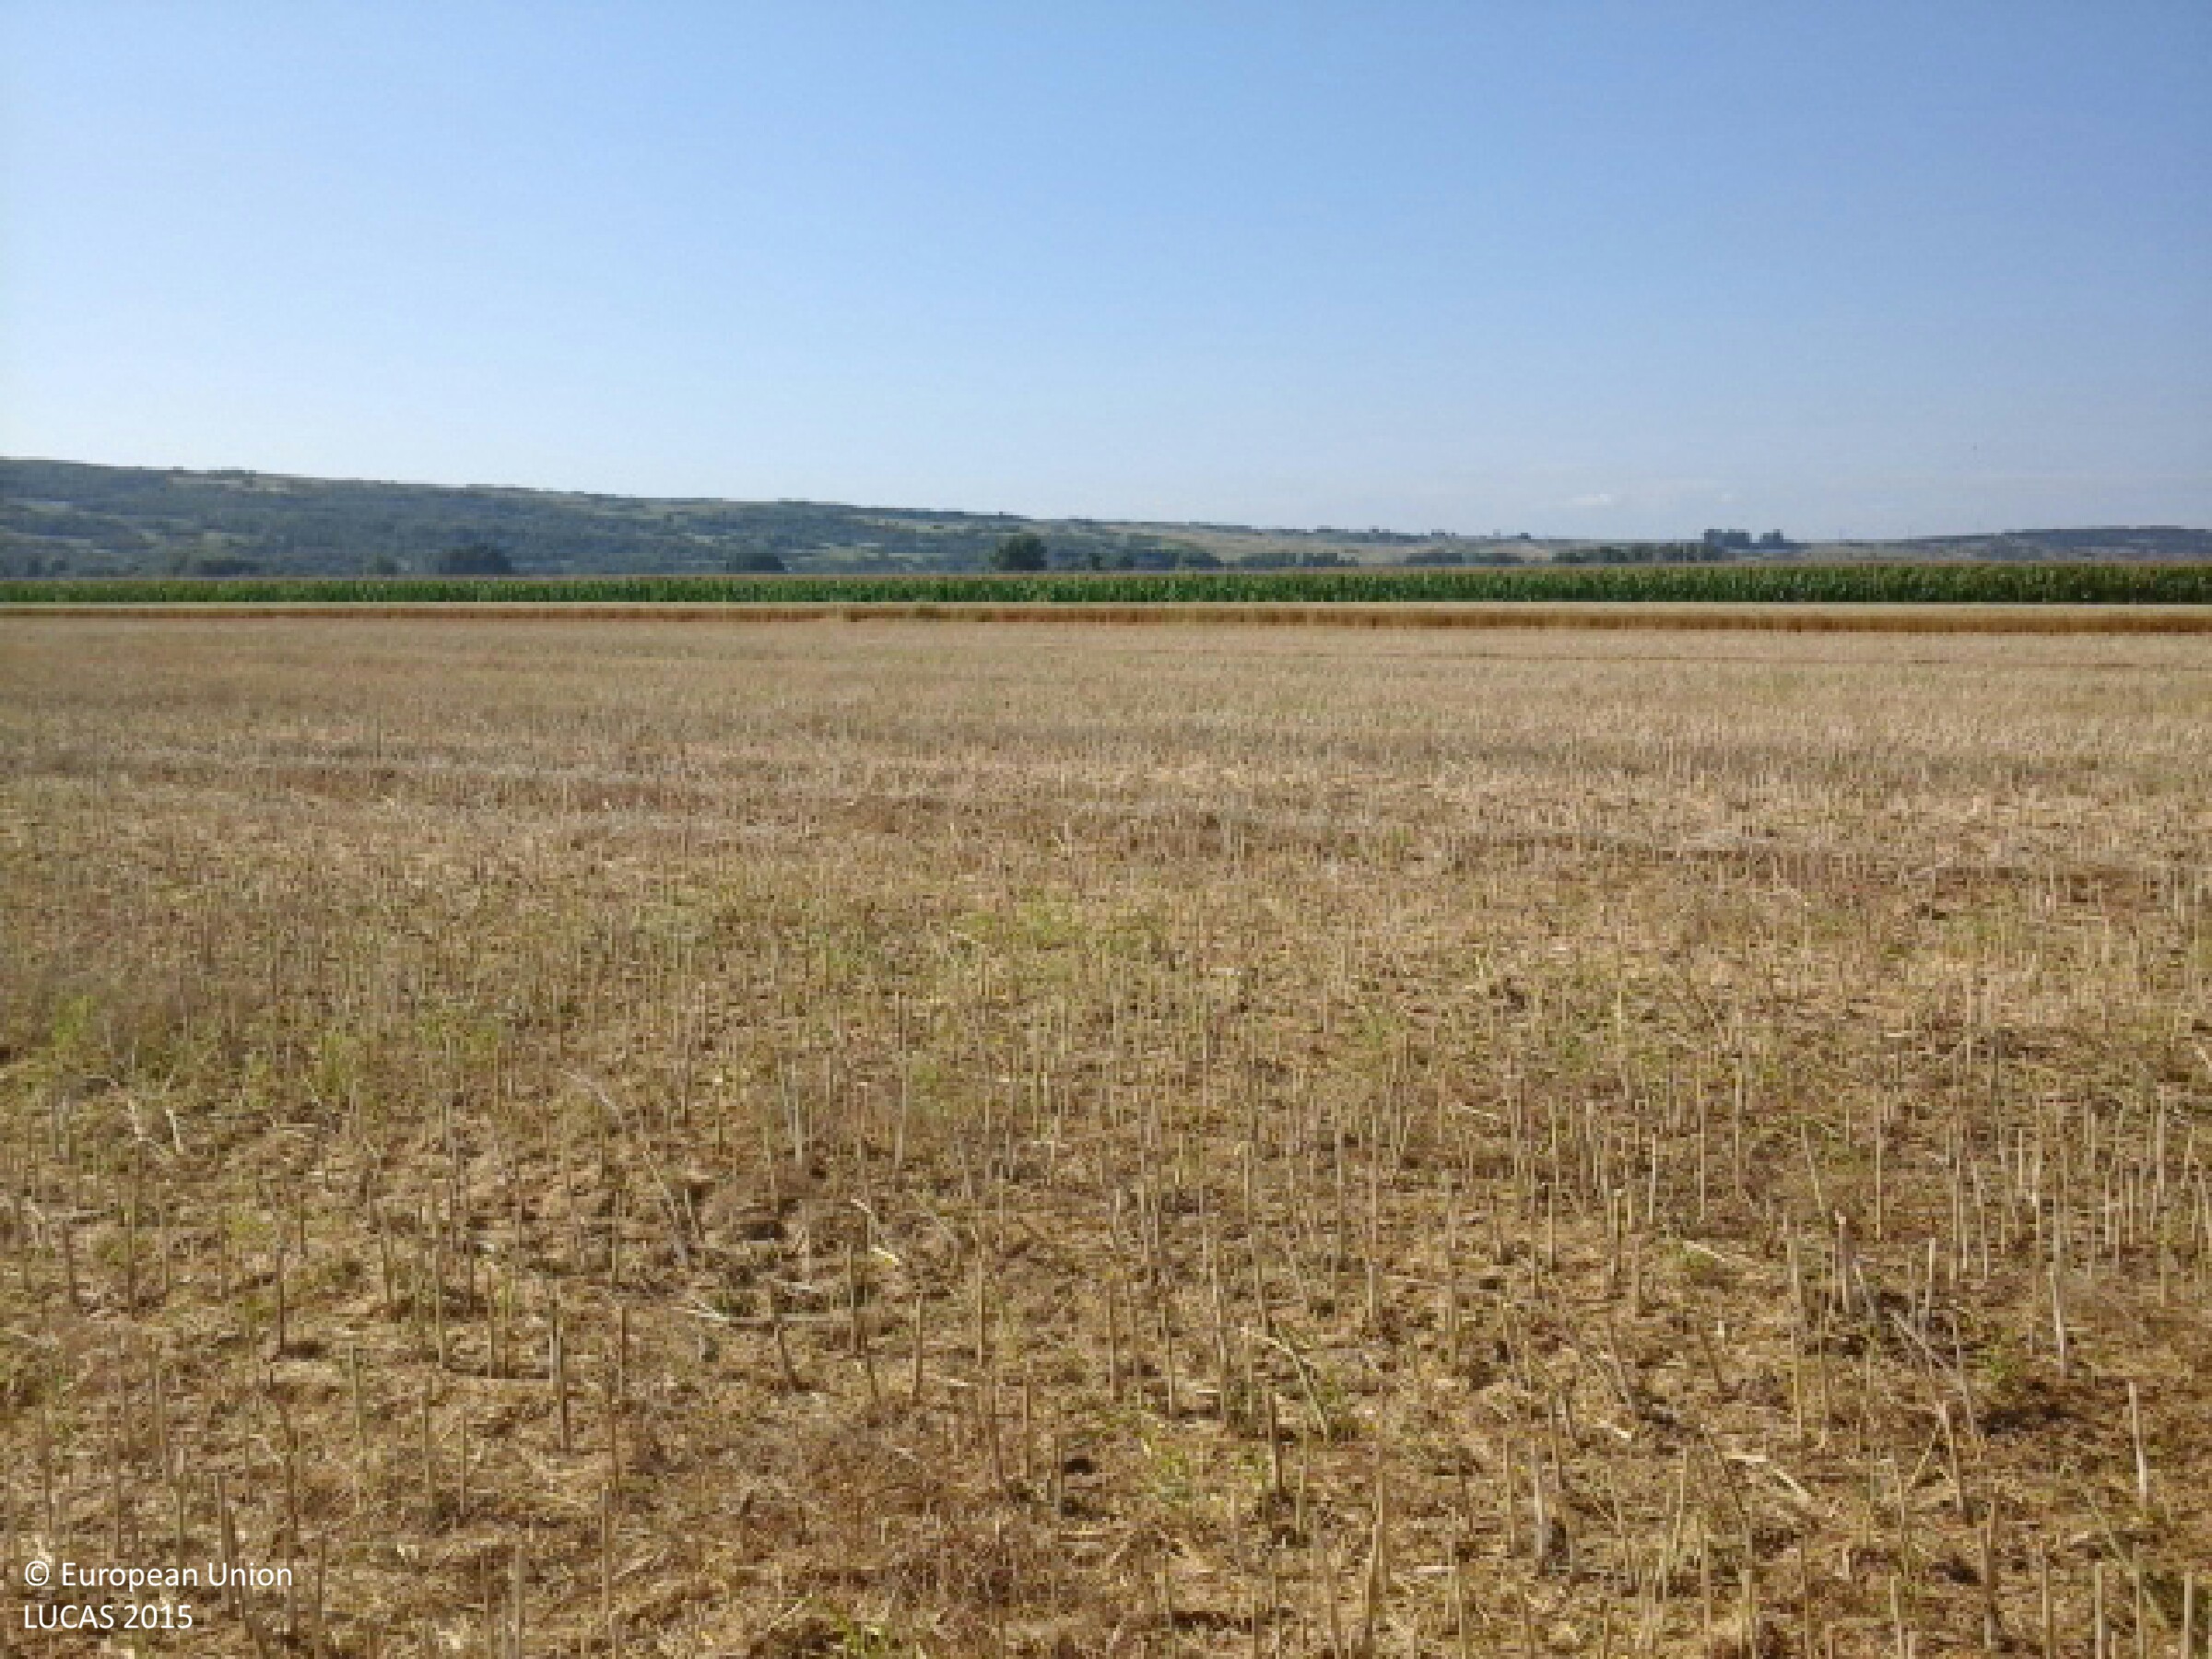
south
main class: Cropland
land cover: Rape and turnip rape
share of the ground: 10 - 25 %
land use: Agriculture (excluding fallow land and kitchen gardens)
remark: Harvested field
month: July
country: HU
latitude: 48.2809
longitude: 21.0775
